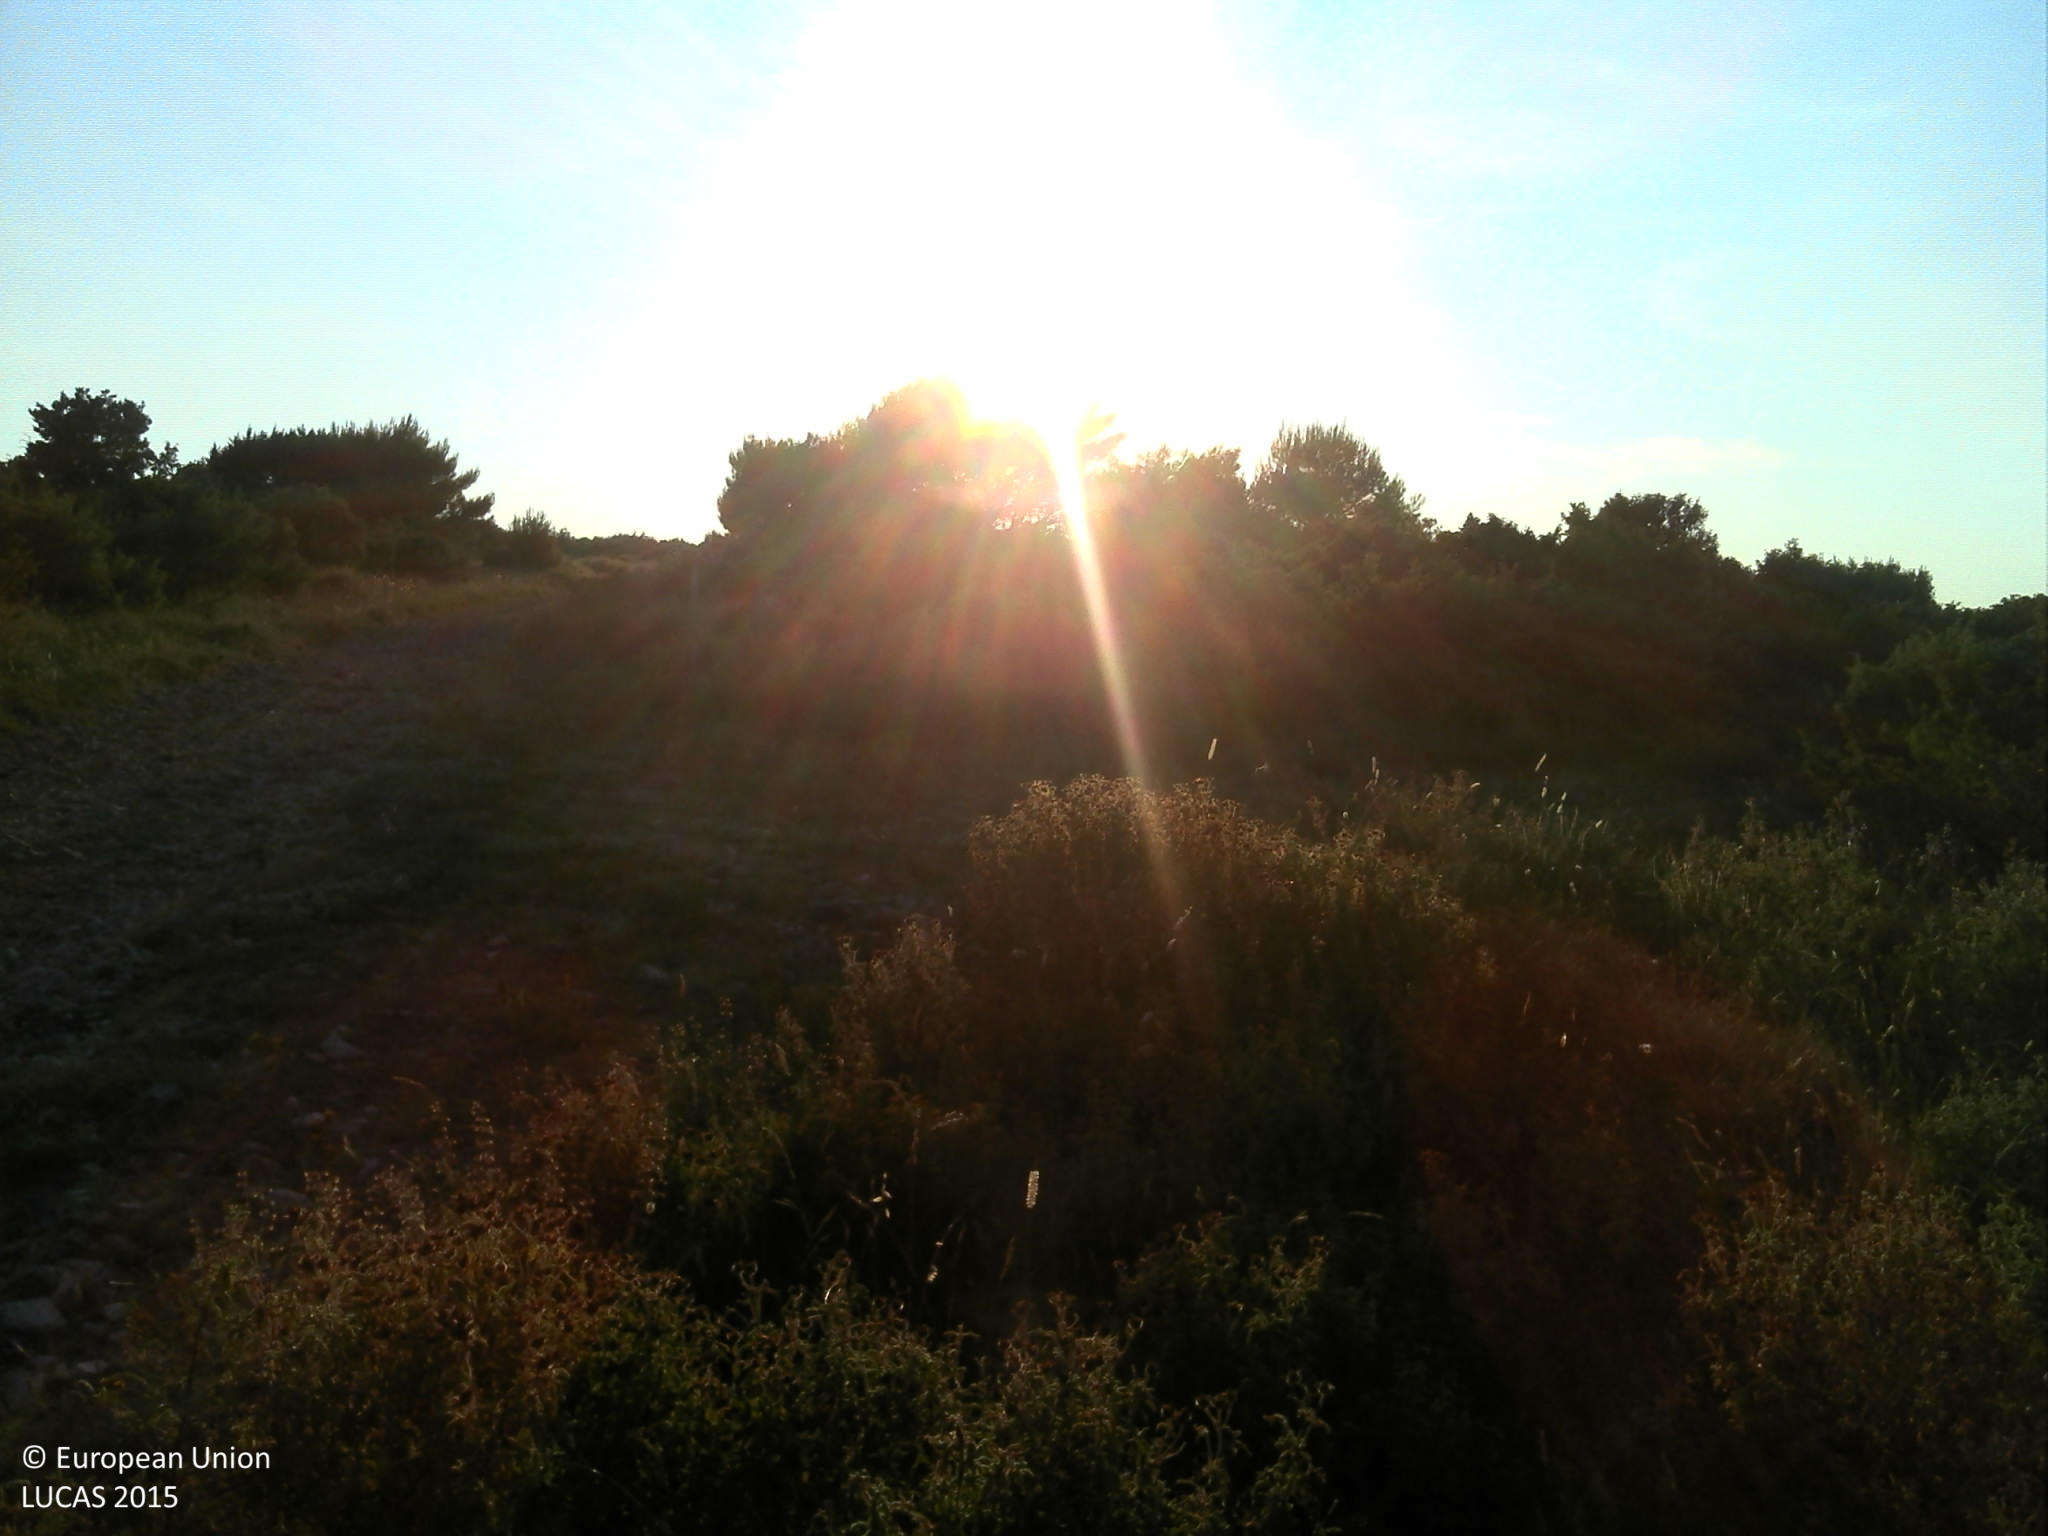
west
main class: Shrubland
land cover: Shrubland without tree cover
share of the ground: 50 - 75 %
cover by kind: shrubs 70 %, herbaceous plants 20 %, consolidated bare surface 5 %, unconsolidated bare surface 5 %
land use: Semi-natural and natural areas not in use
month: July
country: HR
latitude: 43.4861
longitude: 16.3584
